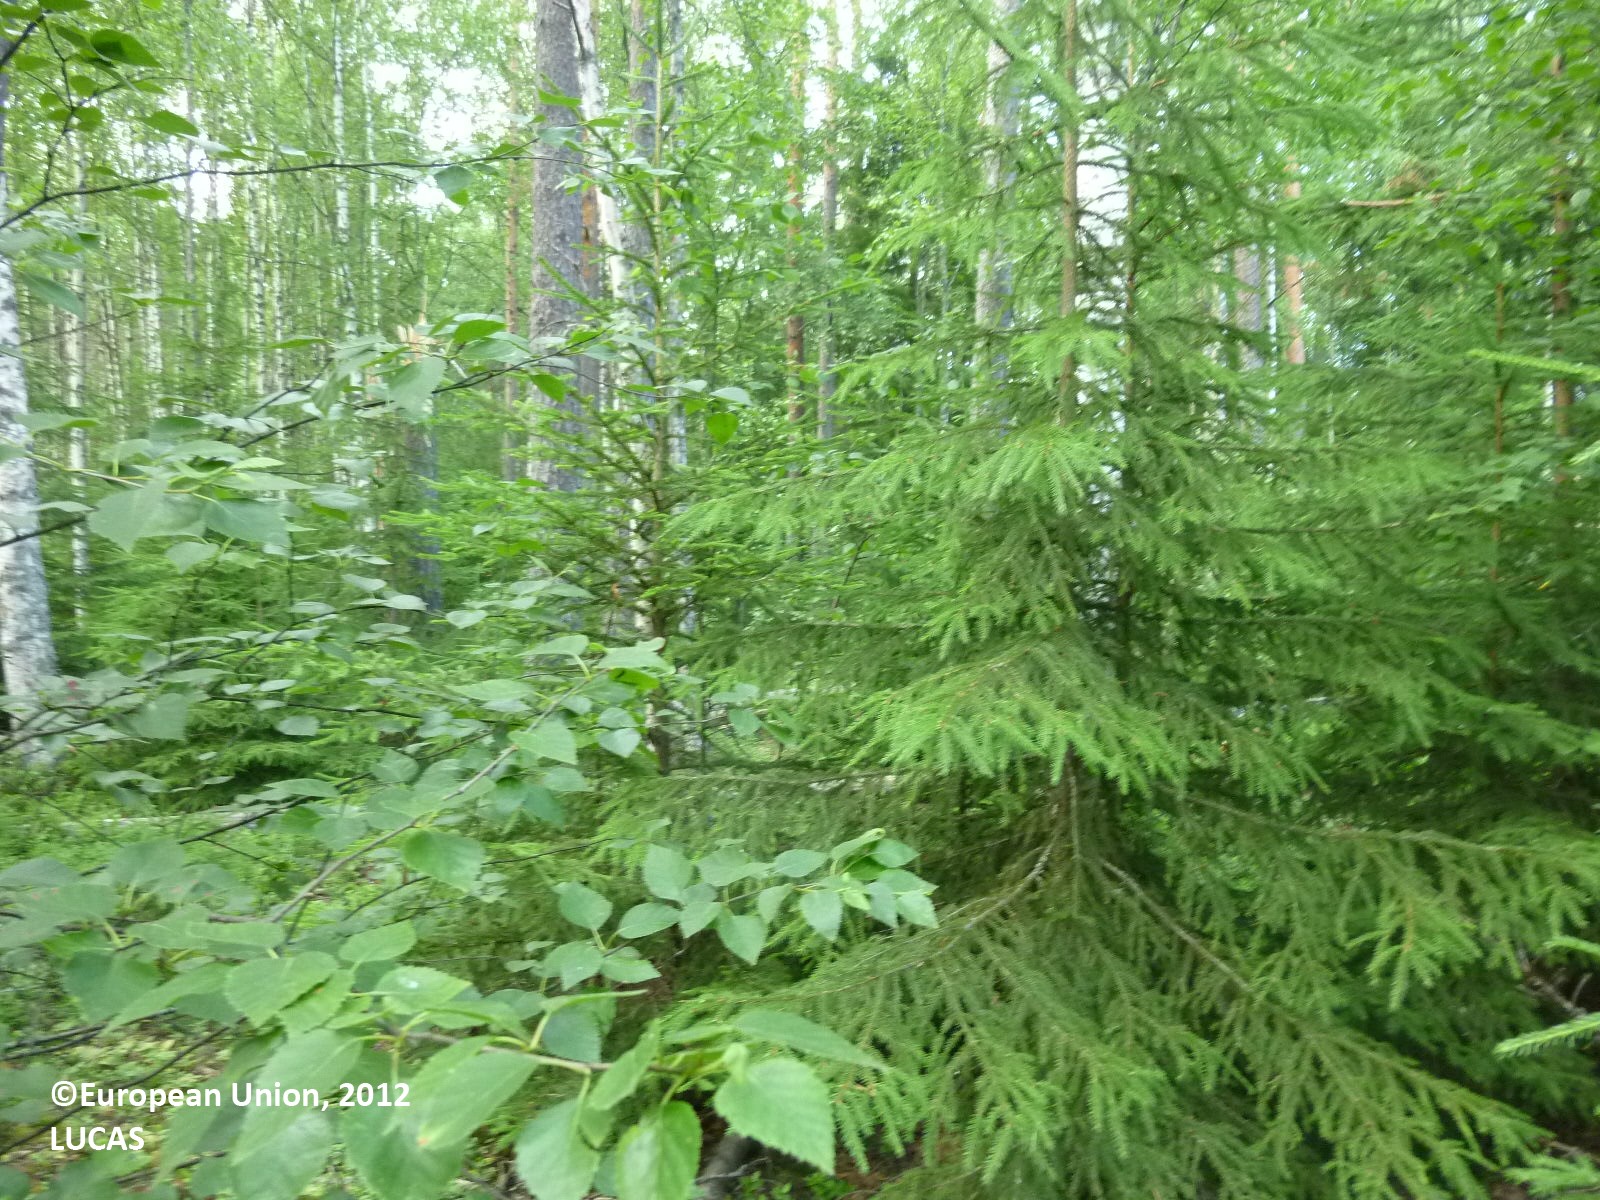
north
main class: Woodland
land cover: Other mixed woodland
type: boreal forest
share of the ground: > 75 %
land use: Forestry
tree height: > 5 m
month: July
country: FI
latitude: 61.3638
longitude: 22.4274
